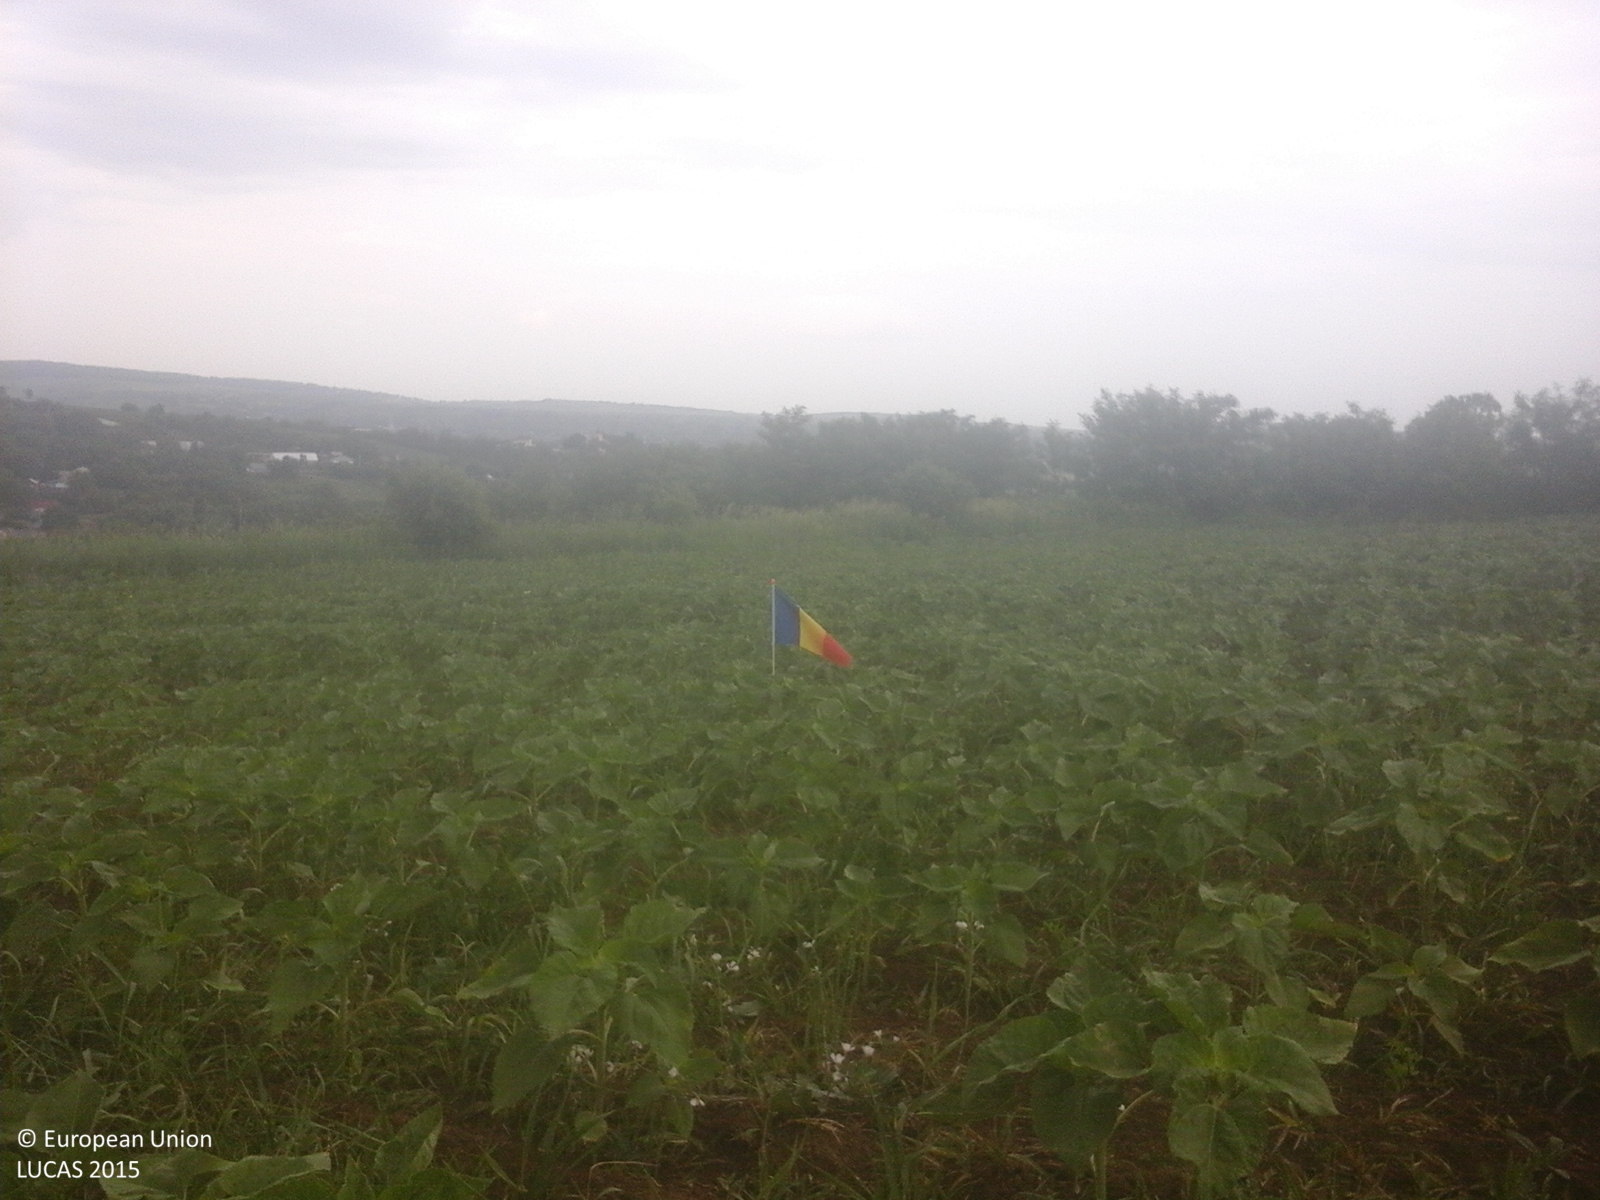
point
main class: Cropland
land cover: Sunflower
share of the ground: 25 - 50 %
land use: Agriculture (excluding fallow land and kitchen gardens)
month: June
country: RO
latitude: 47.0019
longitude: 26.4041
